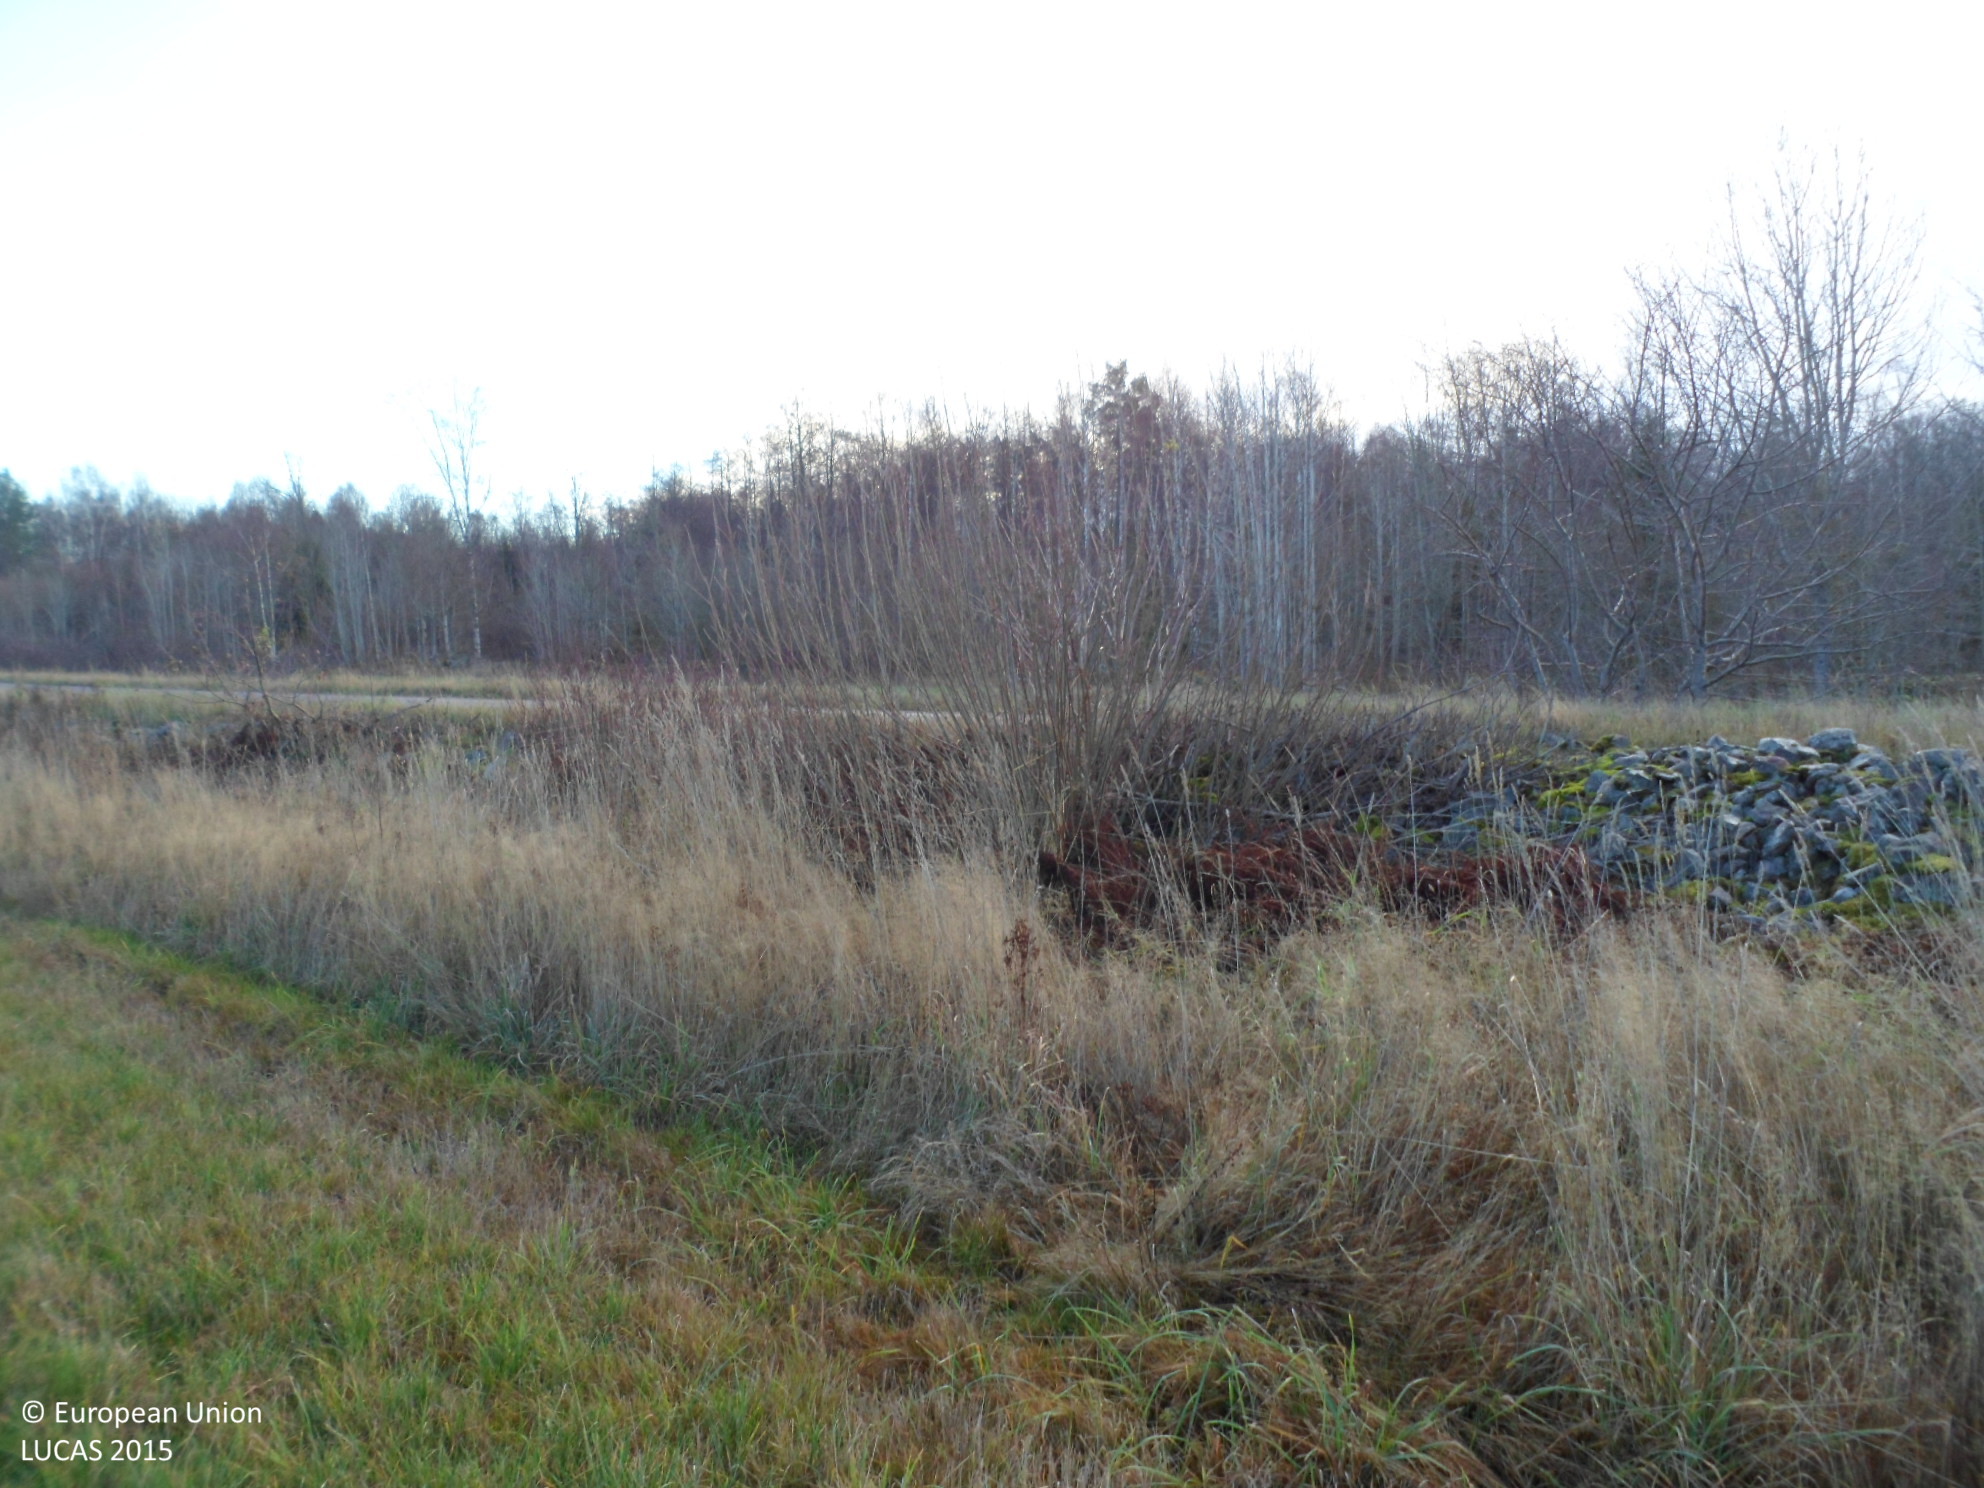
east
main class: Grassland
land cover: Grassland without tree/shrub cover
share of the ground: > 75 %
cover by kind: herbaceous plants 100 %
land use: Agriculture (excluding fallow land and kitchen gardens)
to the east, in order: Grassland without tree/shrub cover; Grass margins; Shrubland with sparse tree cover; Dry stone walls; Grass margins; Paved roads, cycling and walking lanes; Grass margins; Dry stone walls; Shrubland with sparse tree cover; Grassland without tree/shrub cover; Groves; Dry stone walls; Broadleaved woodland; Electric lines; Broadleaved woodland; Tracks; Broadleaved woodland
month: November
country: SE
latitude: 56.9536
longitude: 15.9017
